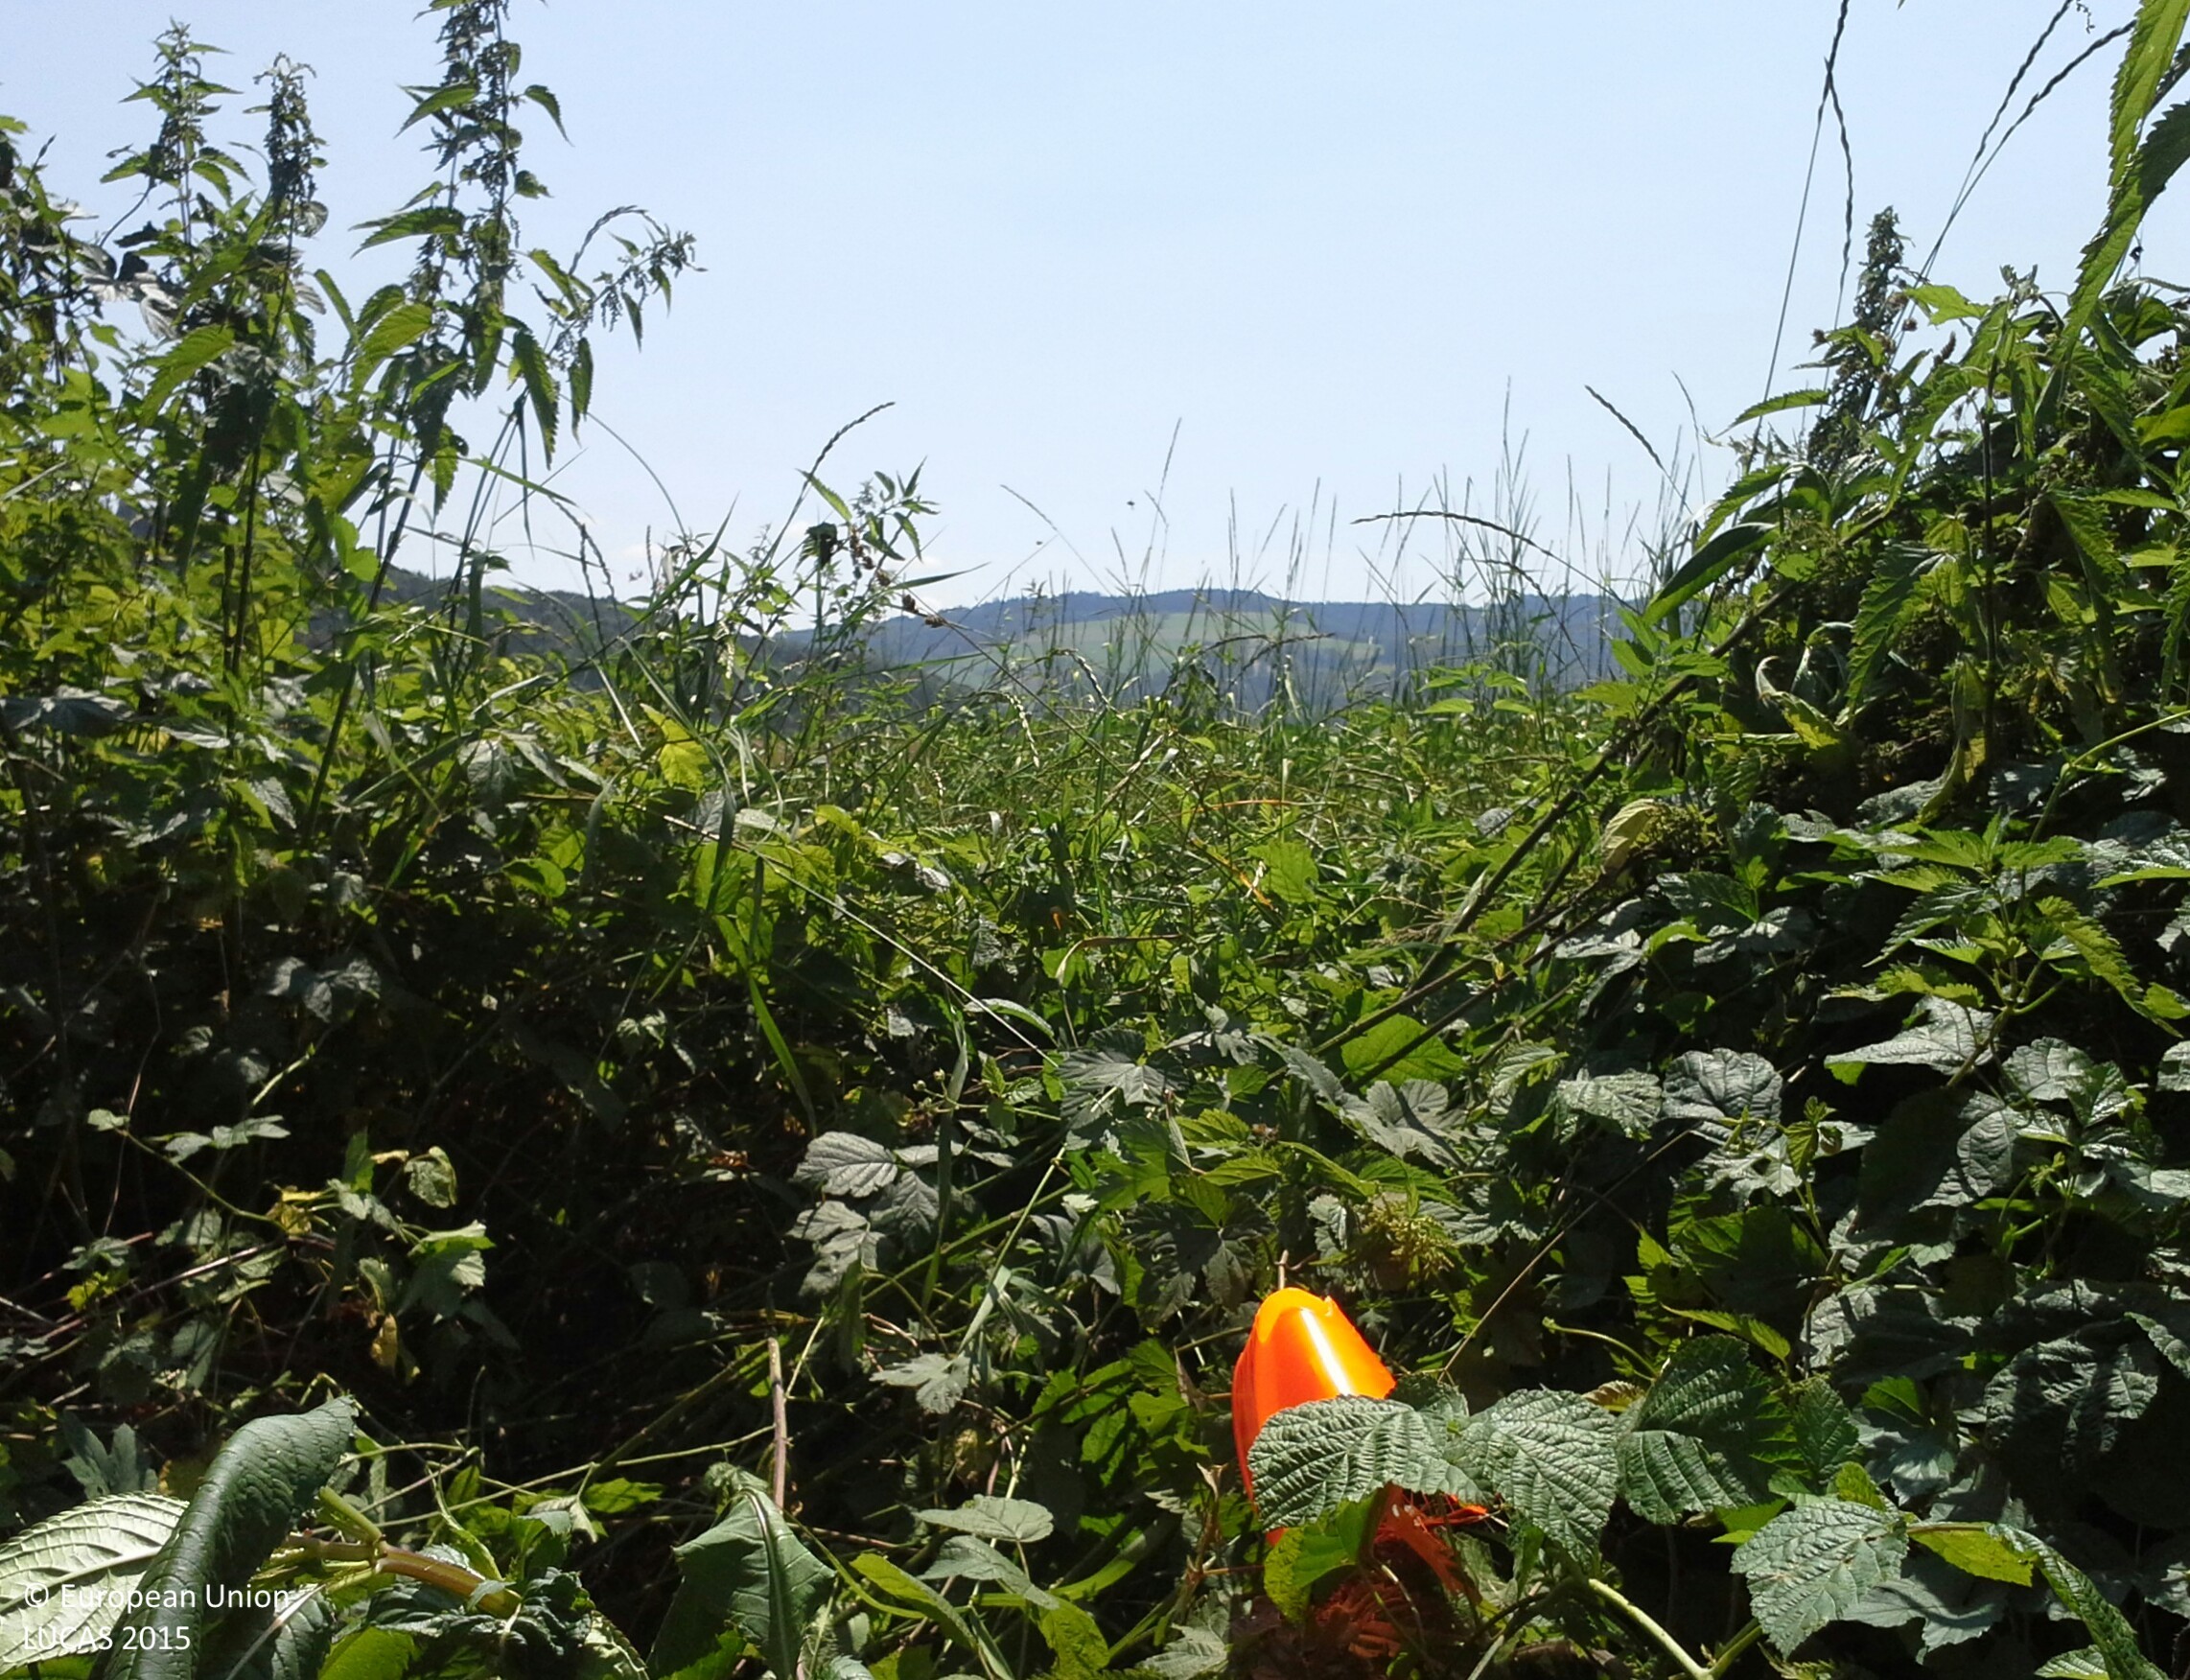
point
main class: Woodland
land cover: Broadleaved woodland
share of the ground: 50 - 75 %
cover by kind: broadleaved forest trees 60 %, shrubs 20 %, herbaceous plants 20 %
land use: Semi-natural and natural areas not in use
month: July
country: AT
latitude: 48.0546
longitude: 15.0323
